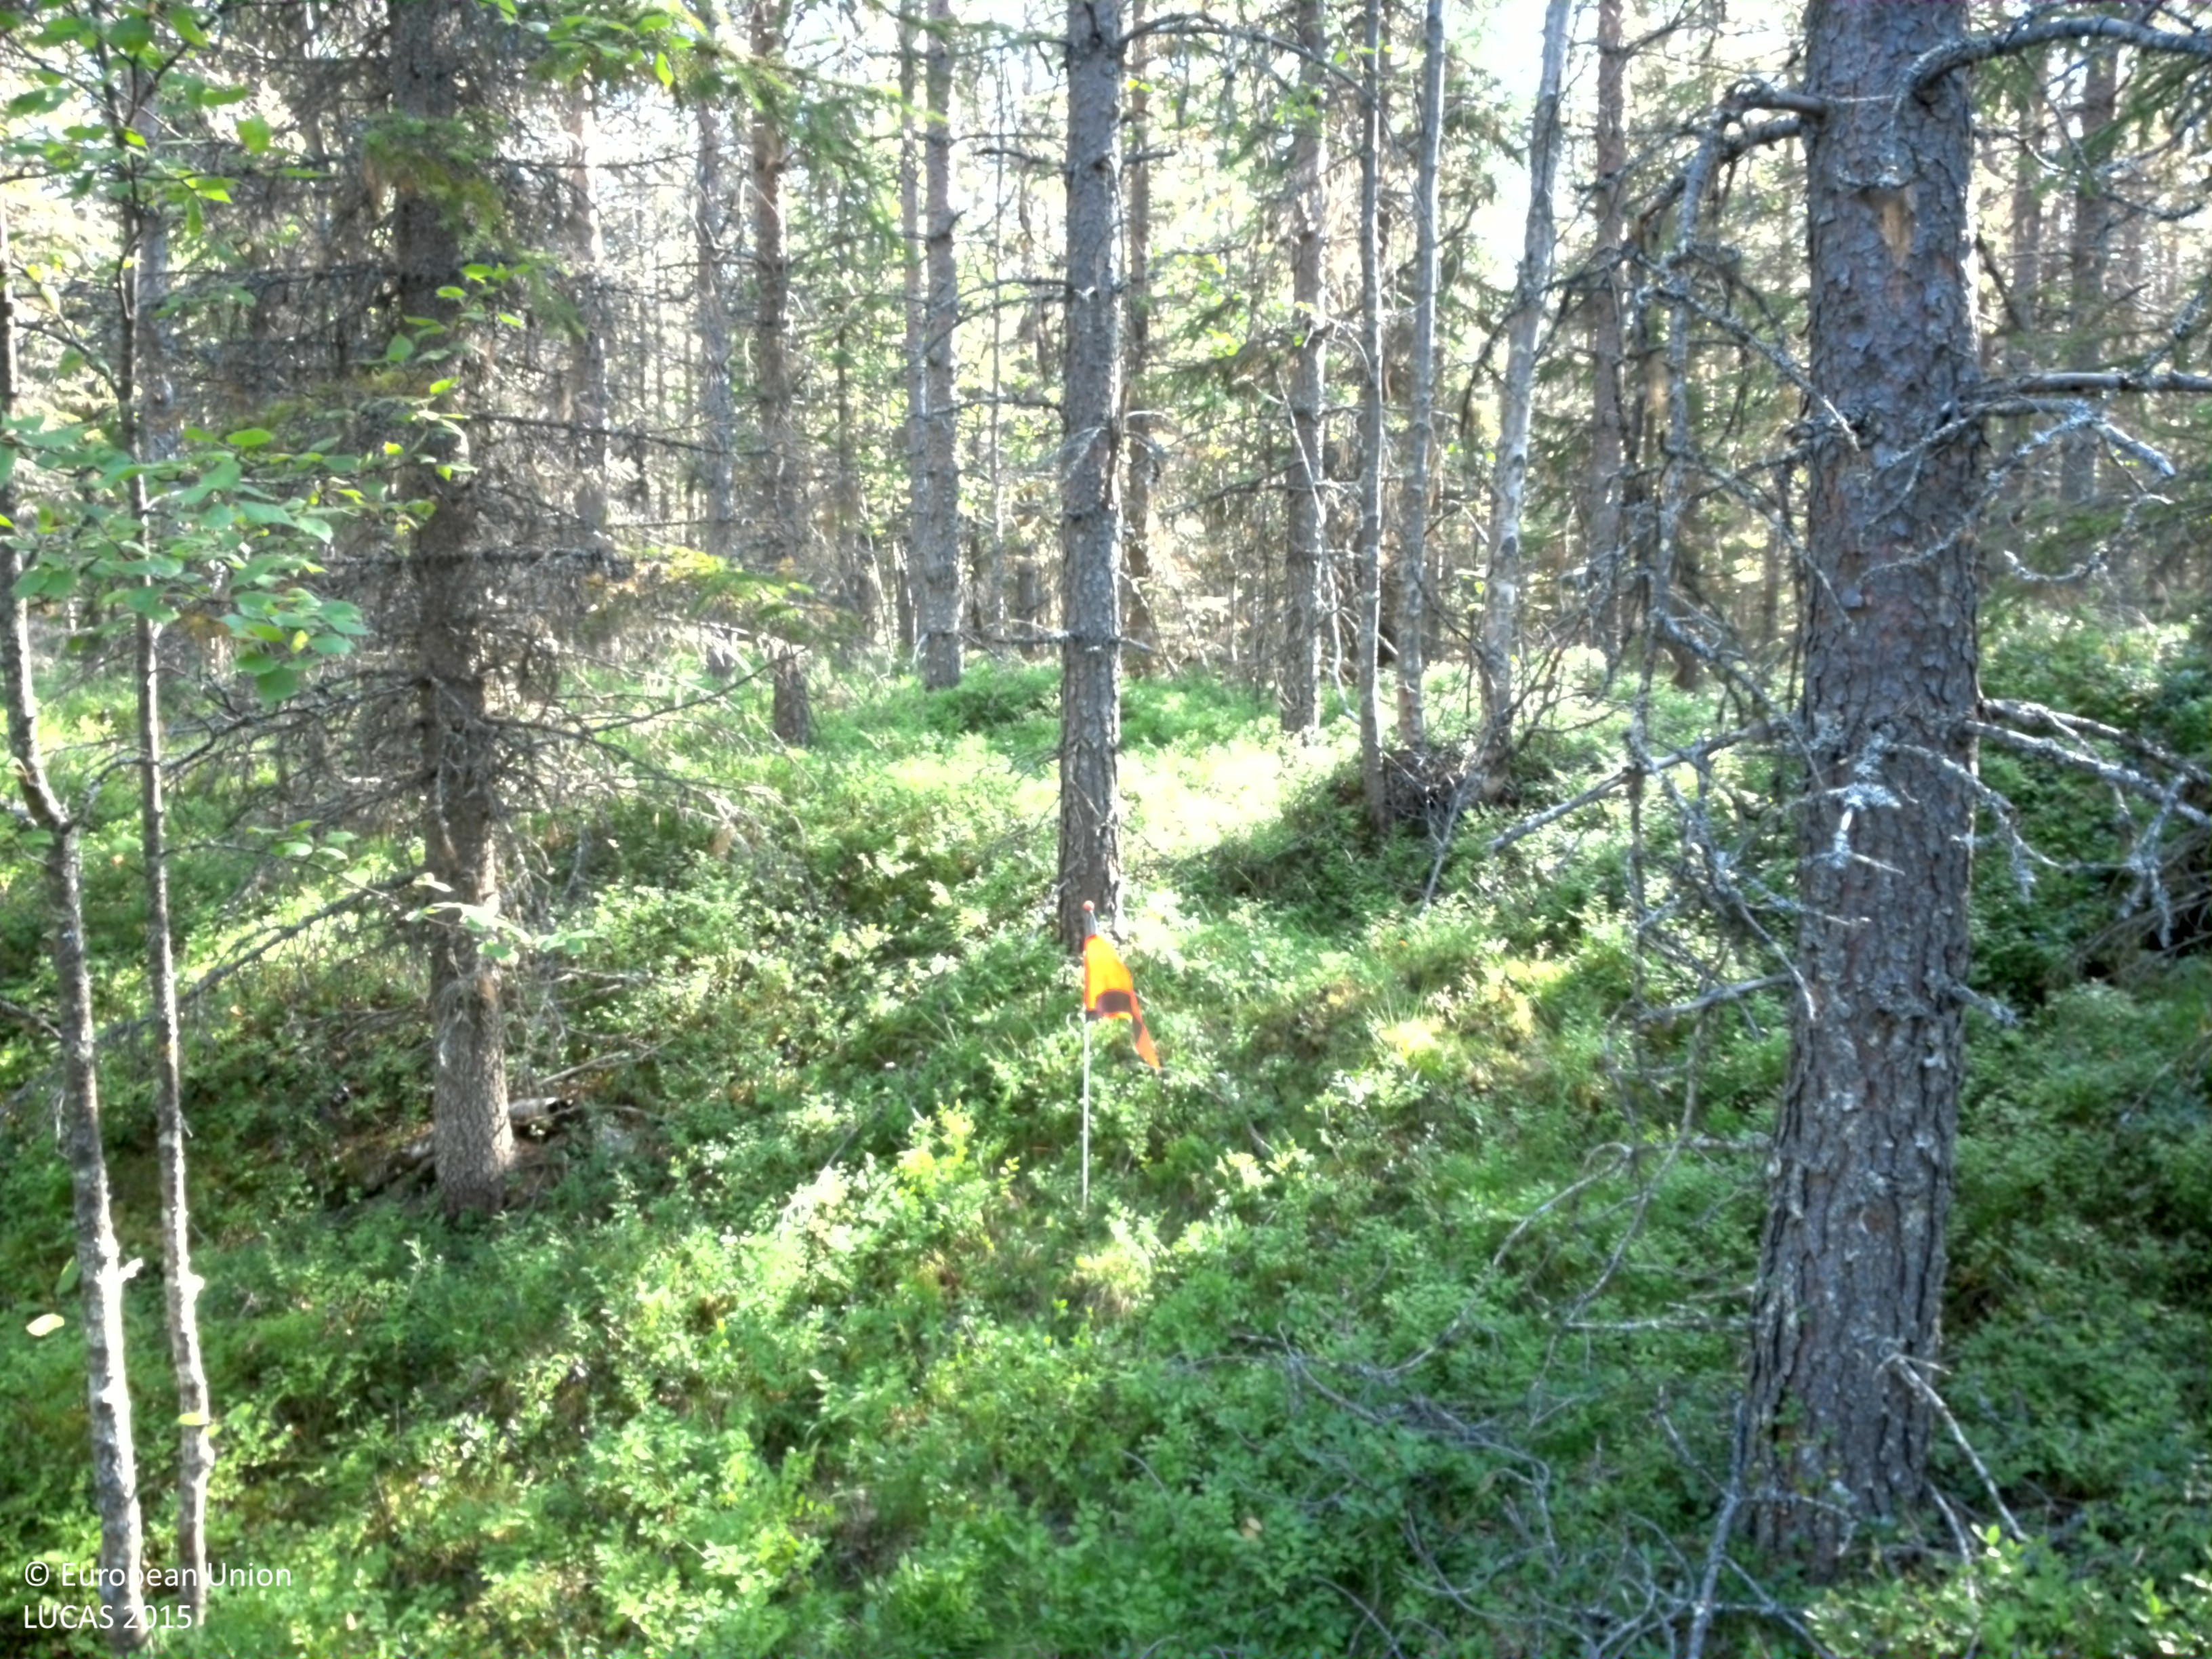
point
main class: Woodland
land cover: Pine dominated coniferous woodland
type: boreal forest
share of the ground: 25 - 50 %
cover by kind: coniferous forest trees 45 %, shrubs 35 %, herbaceous plants 10 %, lichens and mosses 10 %
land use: Forestry
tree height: > 5 m
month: August
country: SE
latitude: 64.6903
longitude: 16.7378
